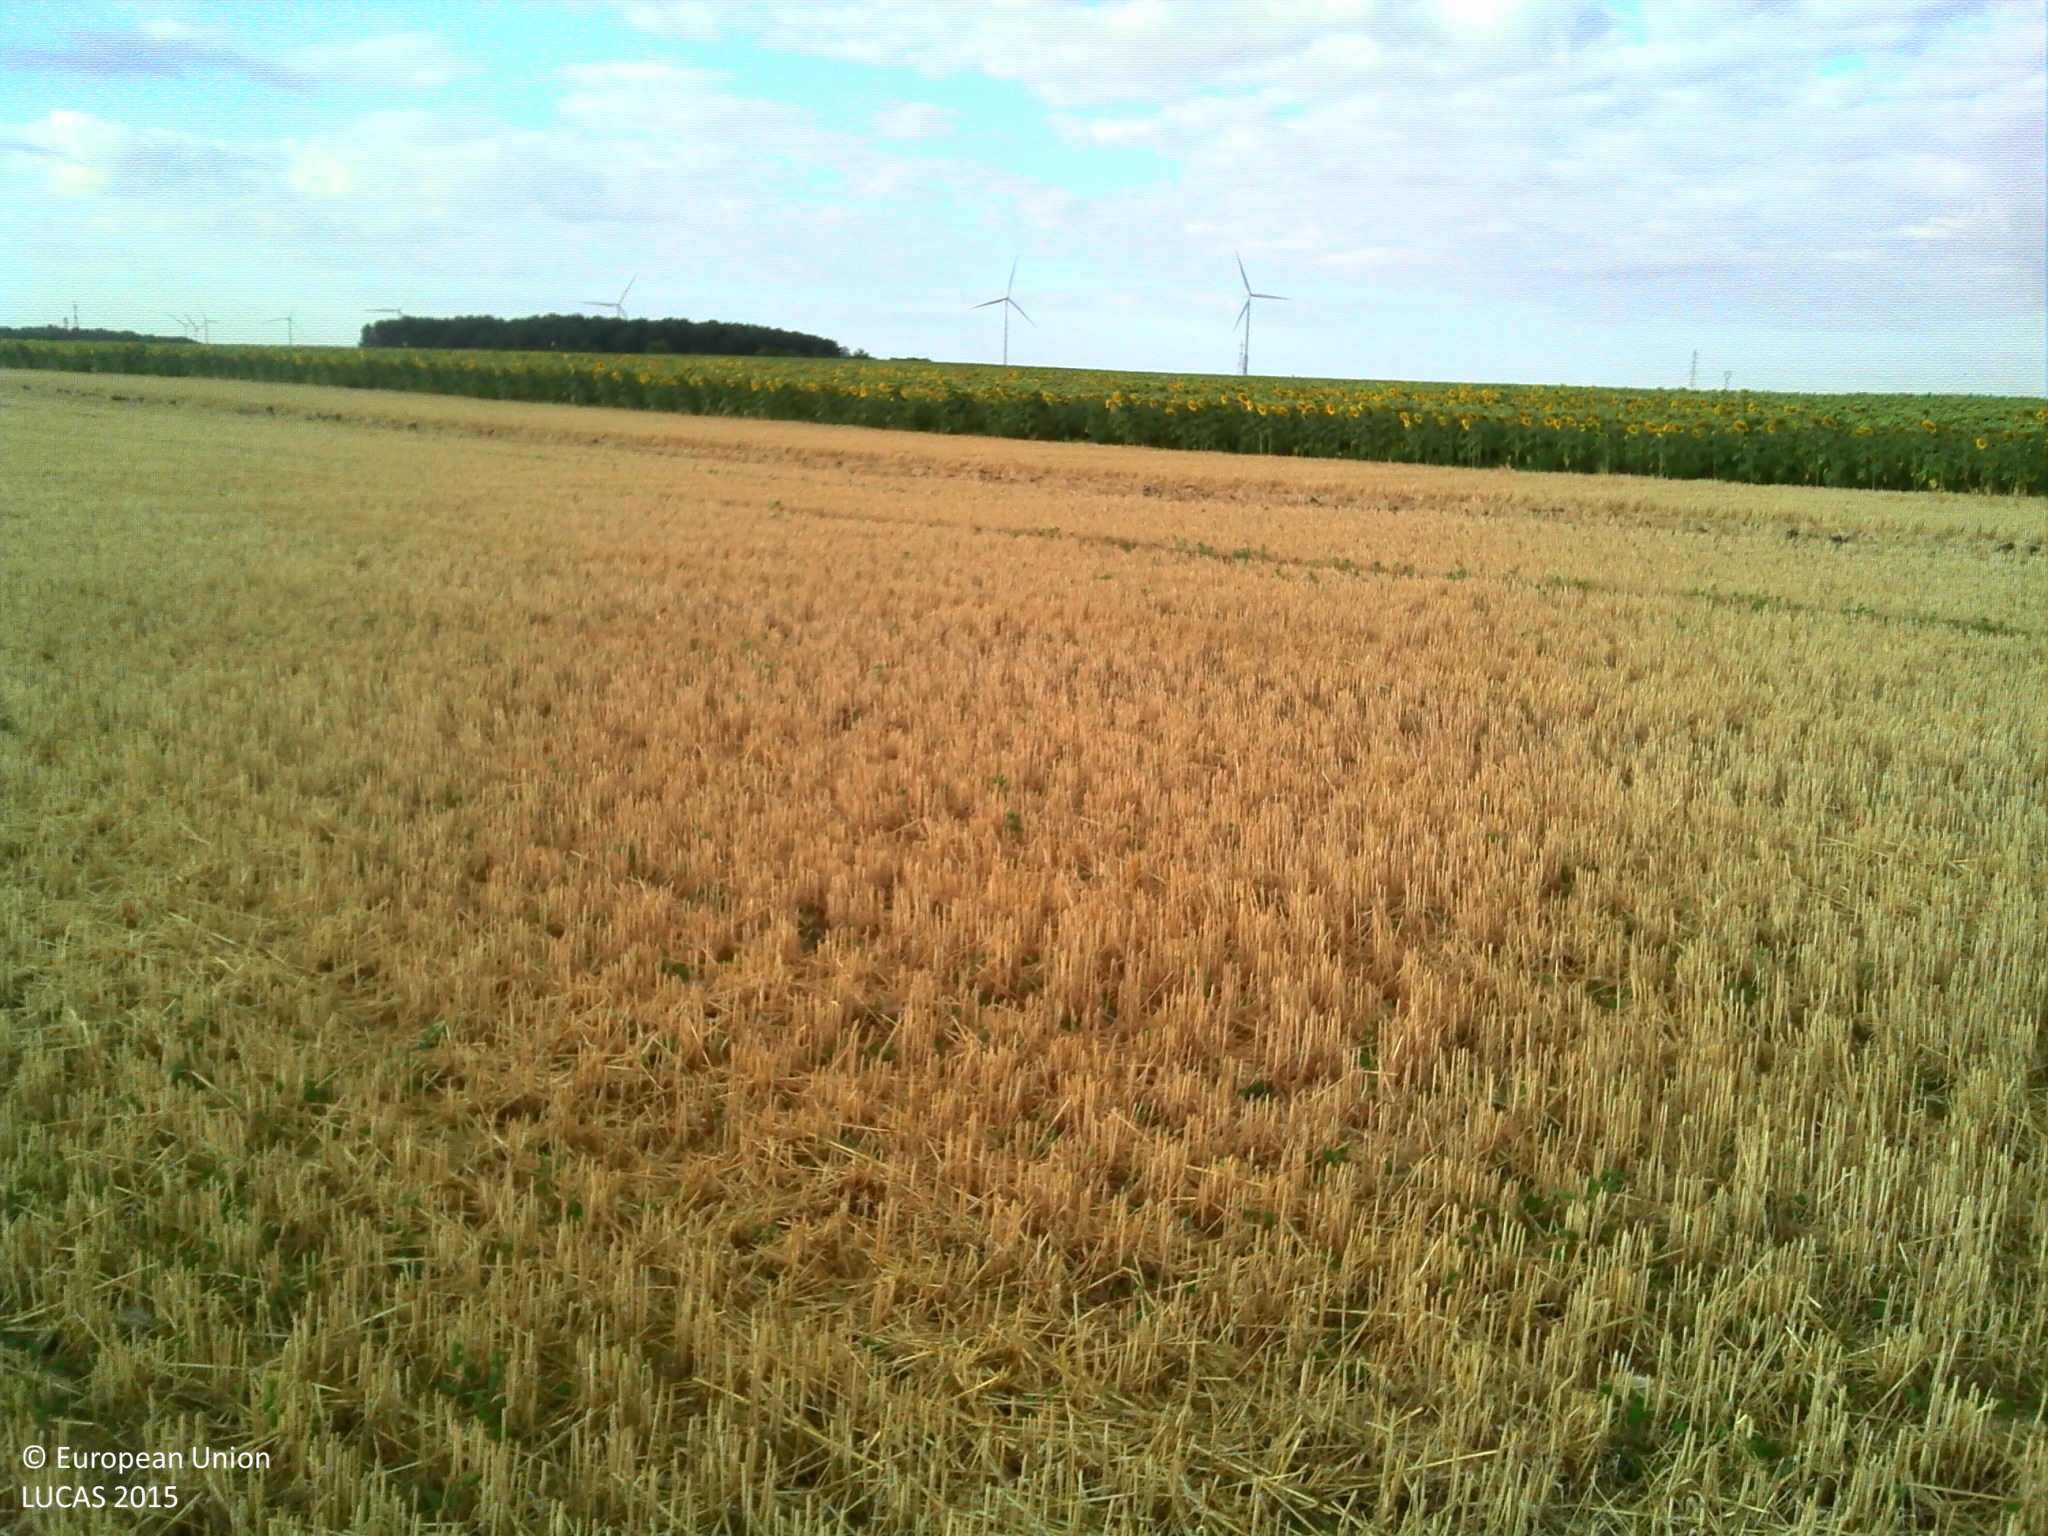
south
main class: Cropland
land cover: Barley
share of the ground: > 75 %
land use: Agriculture (excluding fallow land and kitchen gardens)
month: July
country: FR
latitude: 47.1173
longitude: 2.2287
